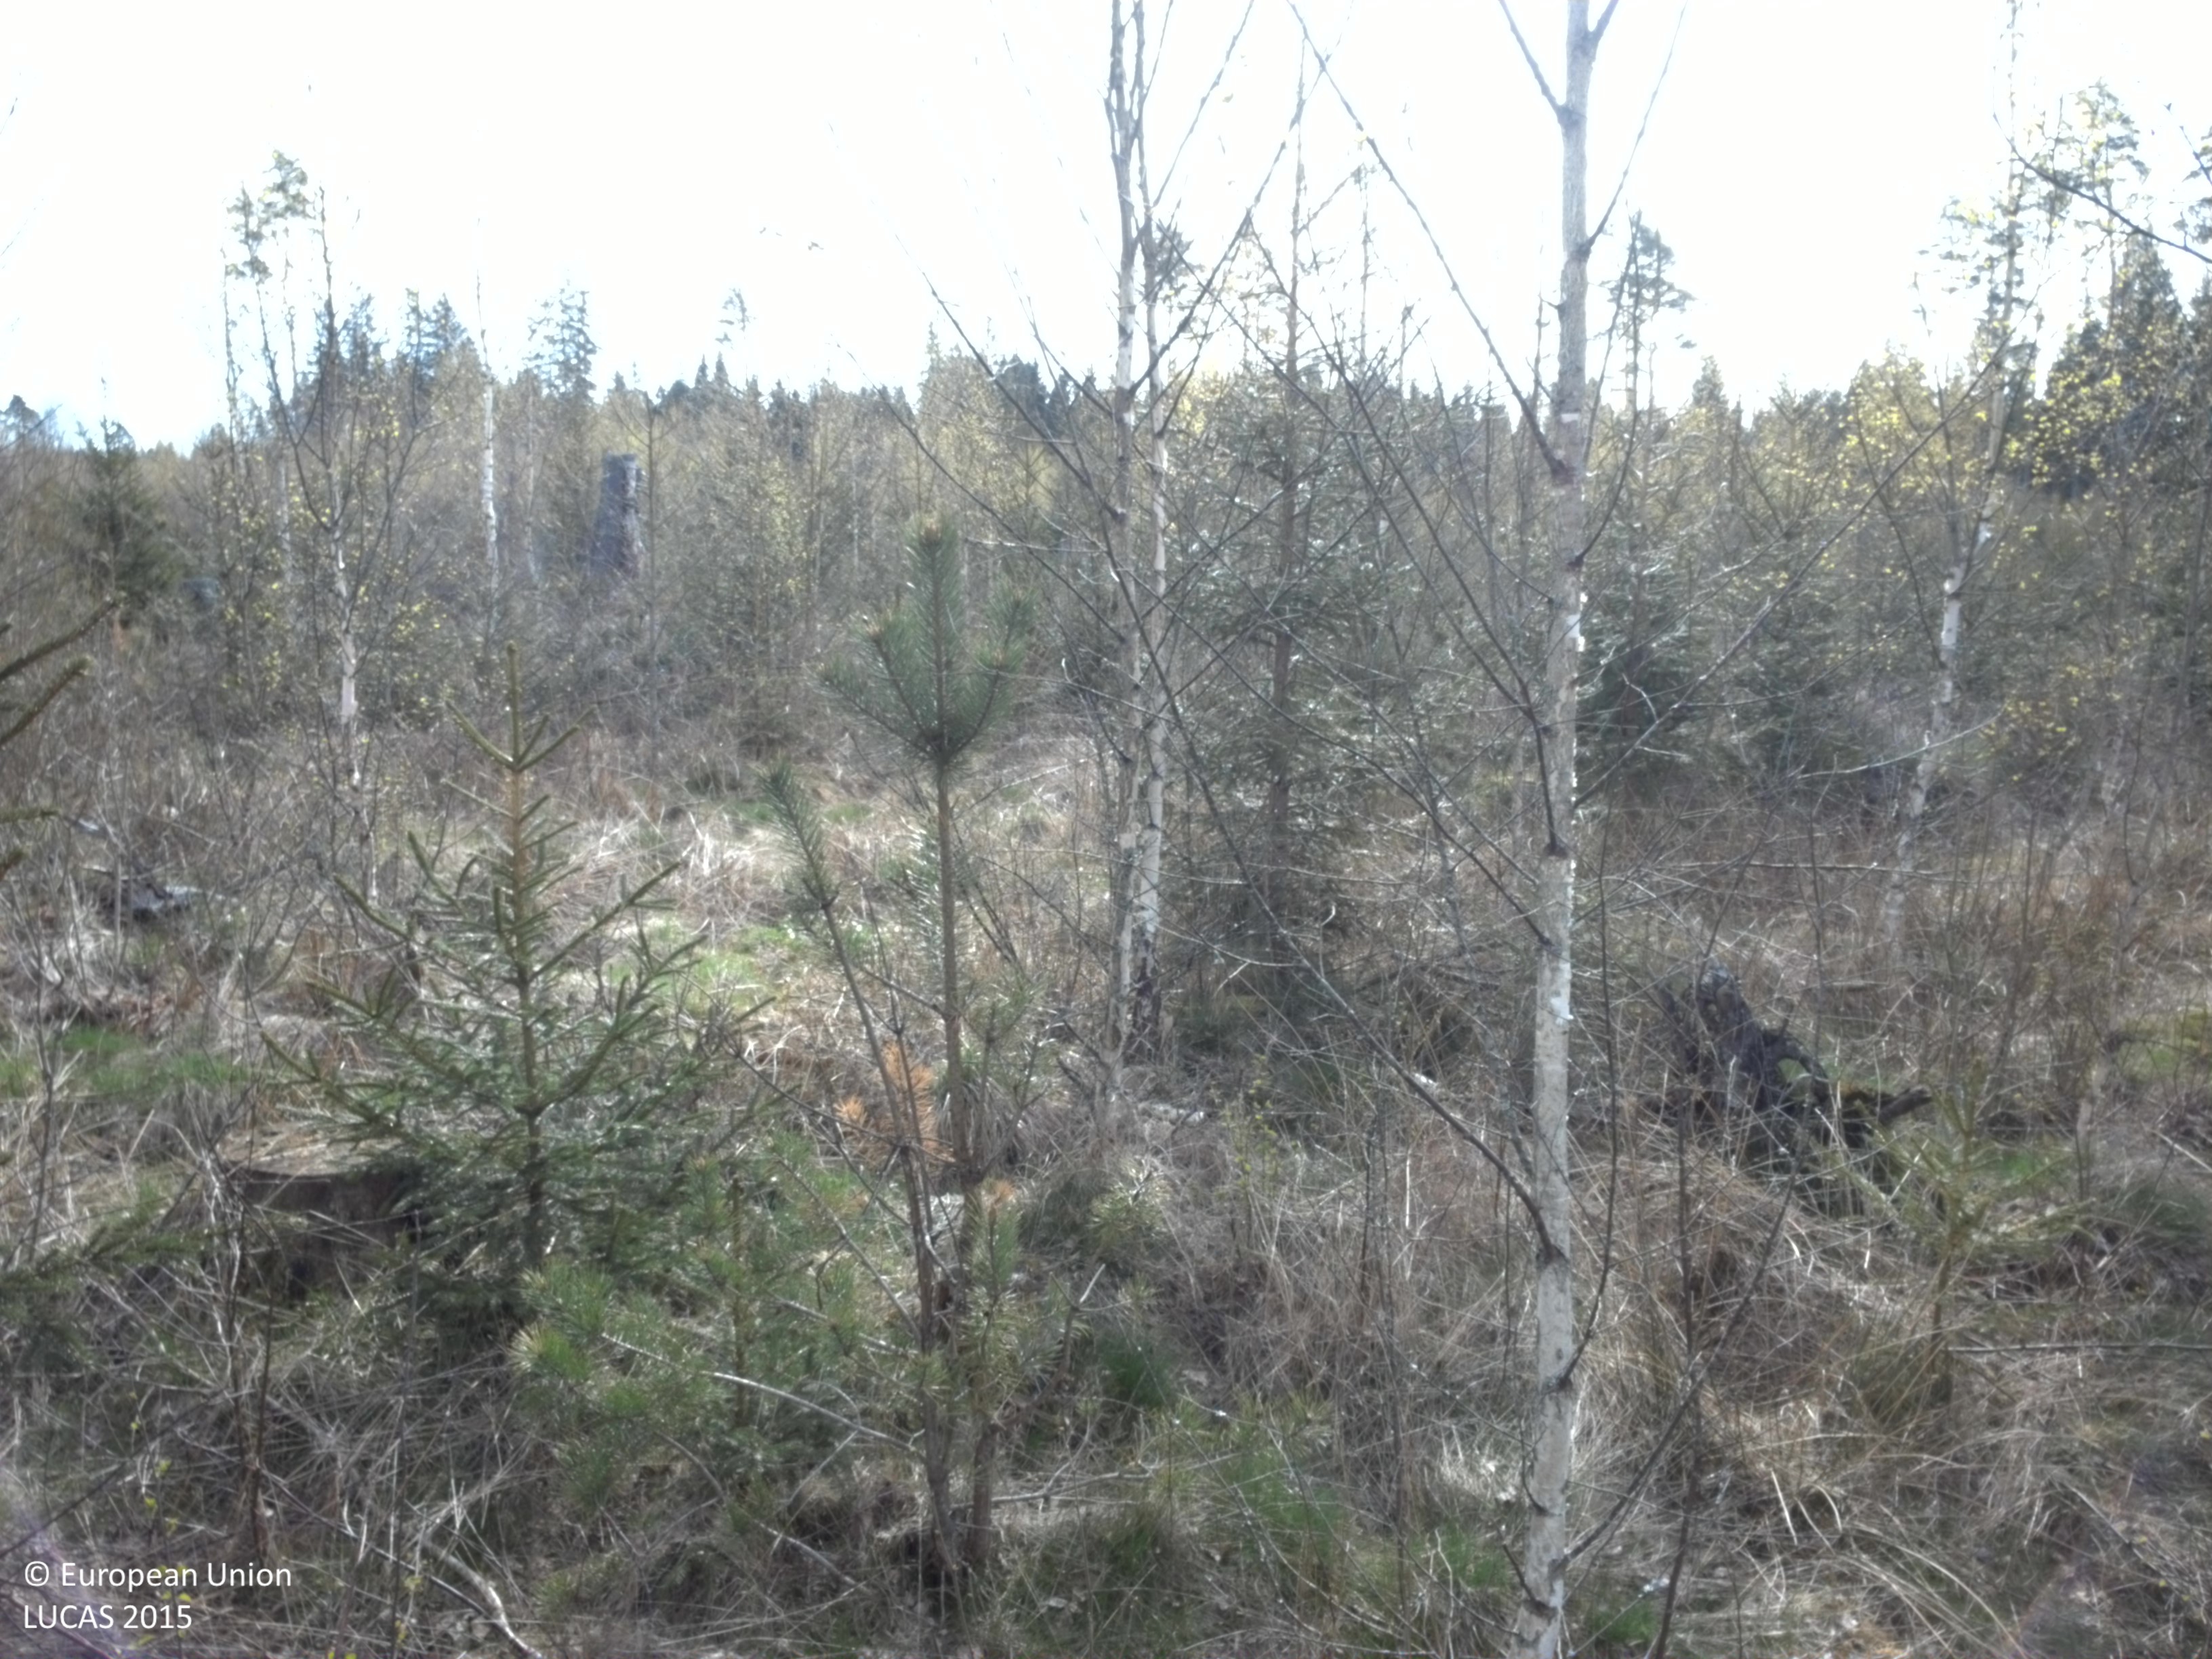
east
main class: Woodland
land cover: Spruce dominated mixed woodland
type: boreal forest
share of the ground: > 75 %
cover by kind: coniferous forest trees 45 %, broadleaved forest trees 45 %
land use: Forestry
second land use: Amenities, museums, leisure
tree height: < 5 m
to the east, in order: Spruce dominated mixed woodland; Ditches and canals; Tracks; Spruce dominated mixed woodland; Ditches and canals; Tracks; Spruce dominated coniferous woodland
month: May
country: SE
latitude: 56.7828
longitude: 14.7929
